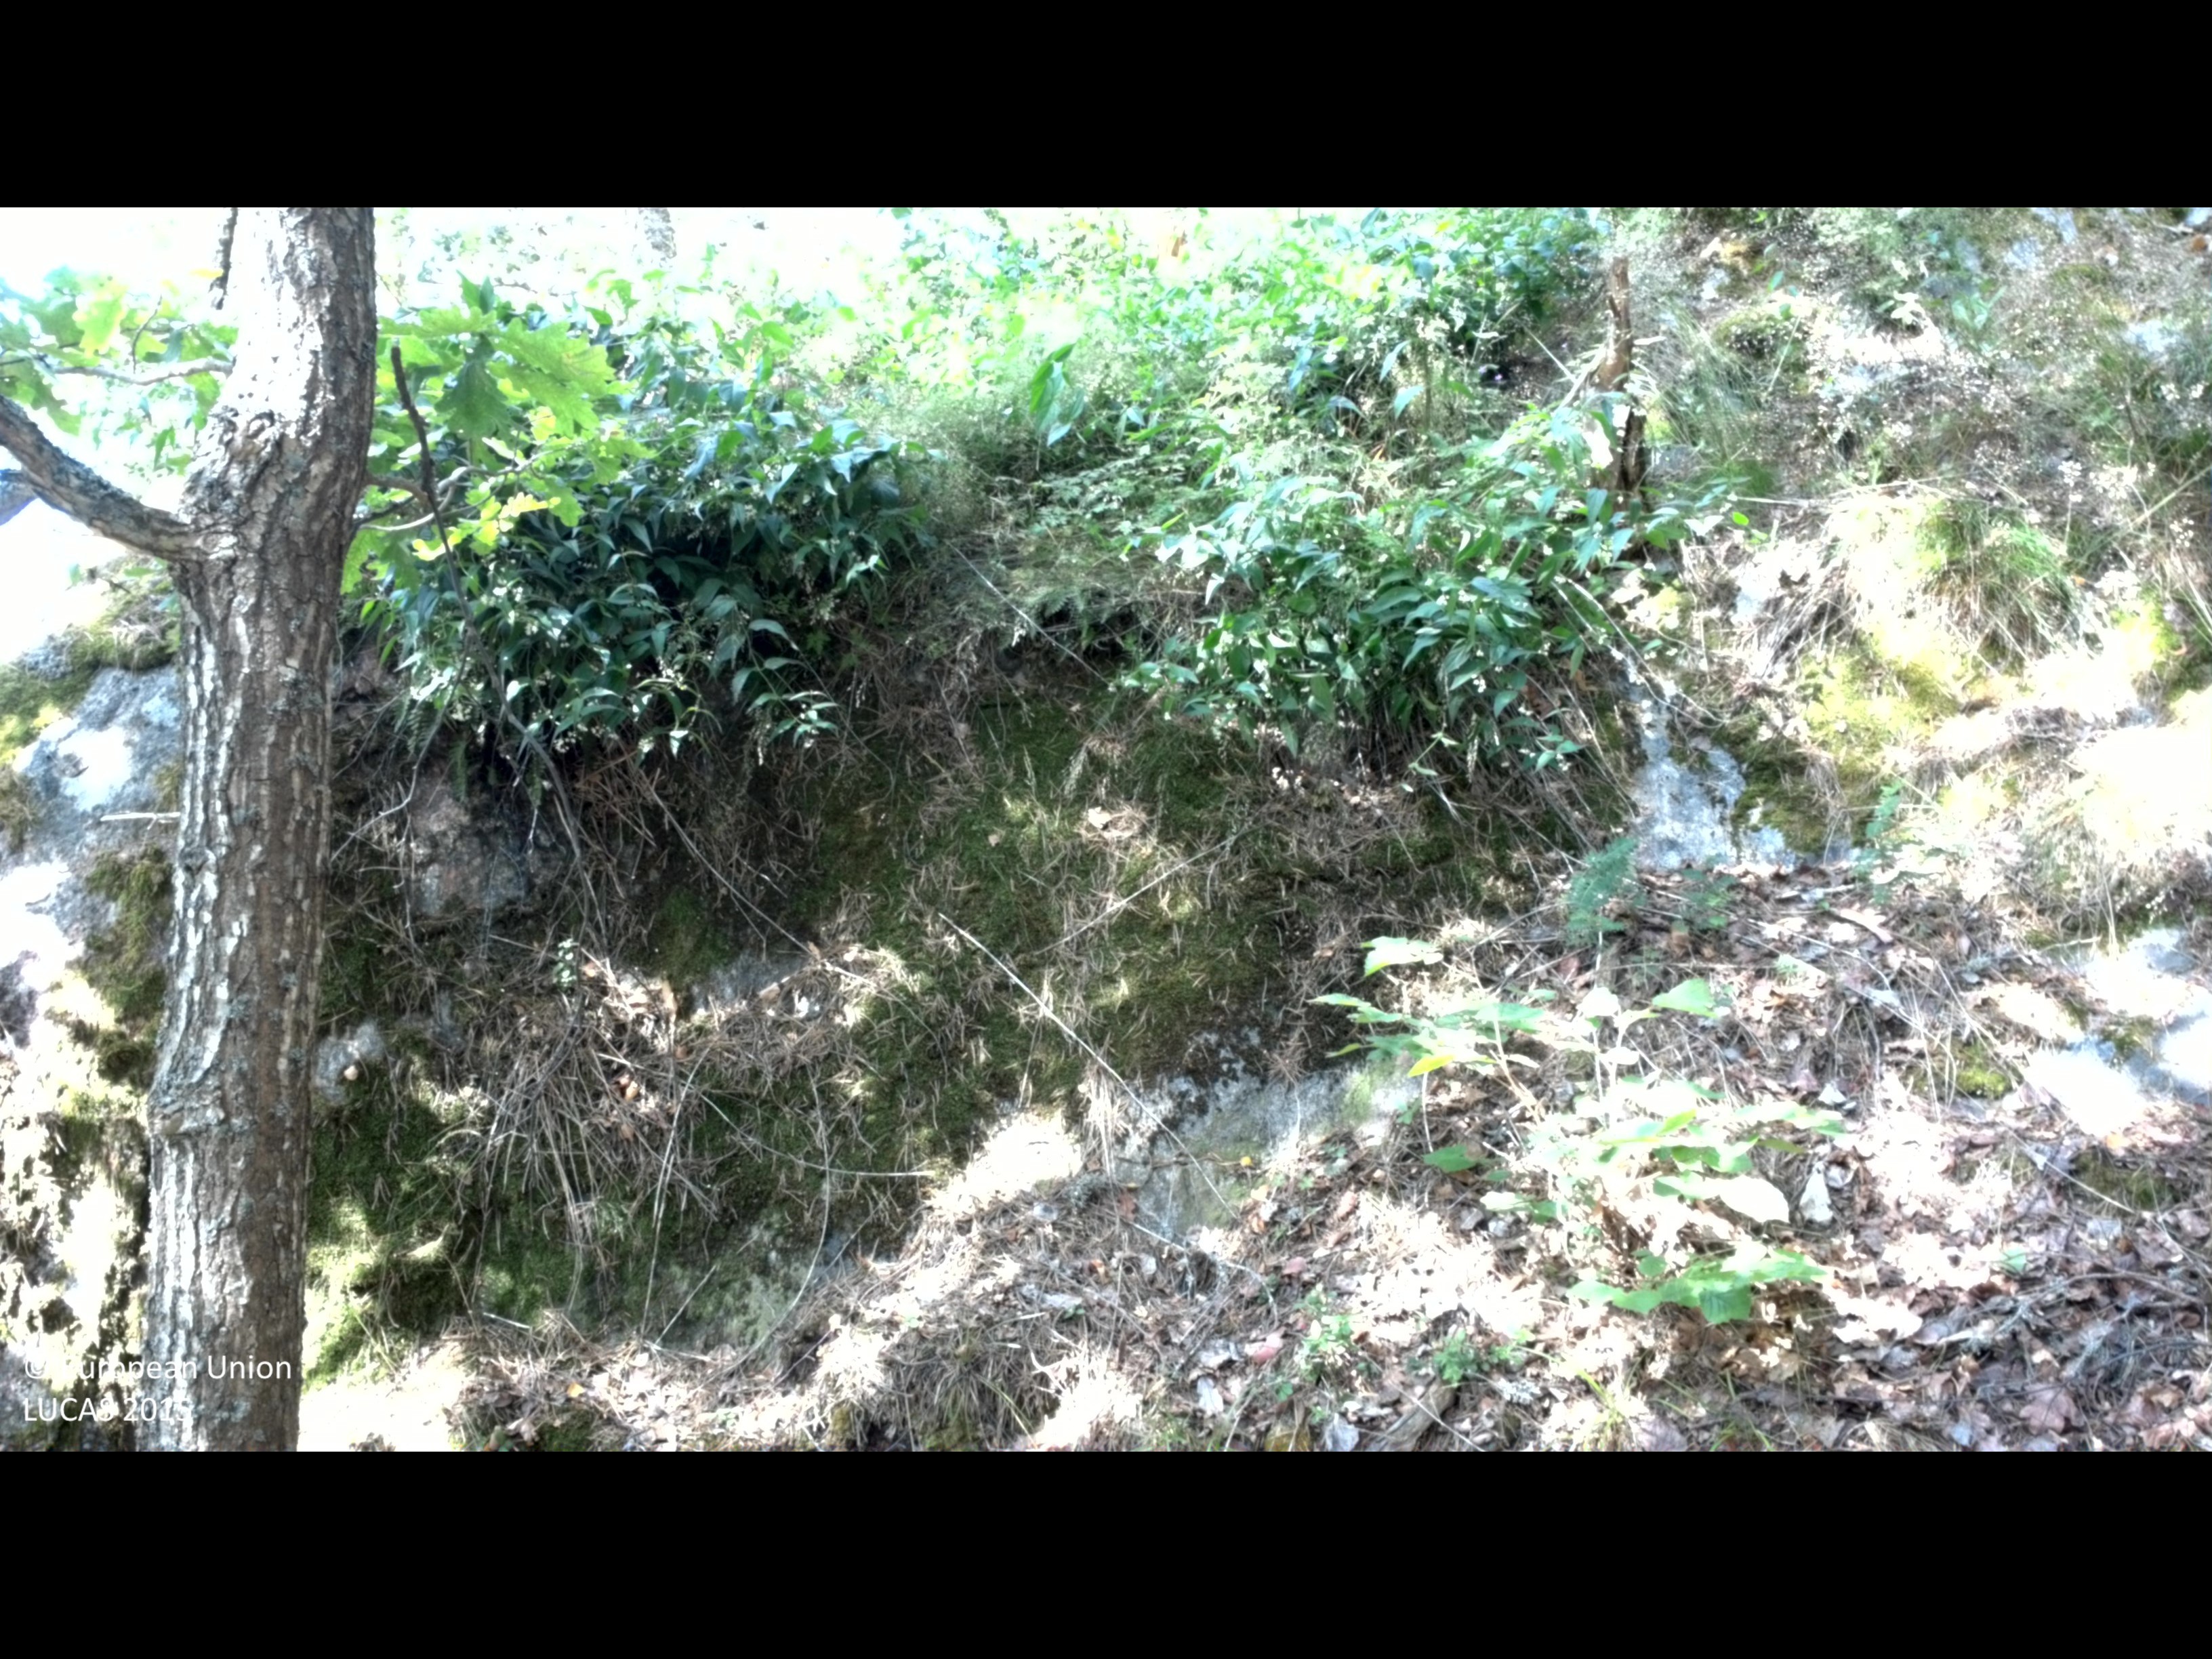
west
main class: Woodland
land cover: Pine dominated mixed woodland
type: boreal forest
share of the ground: 50 - 75 %
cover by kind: coniferous forest trees 40 %, broadleaved forest trees 30 %, shrubs 15 %, lichens and mosses 10 %, herbaceous plants 5 %
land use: Forestry
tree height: > 5 m
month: July
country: SE
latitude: 58.2662
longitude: 16.3888
